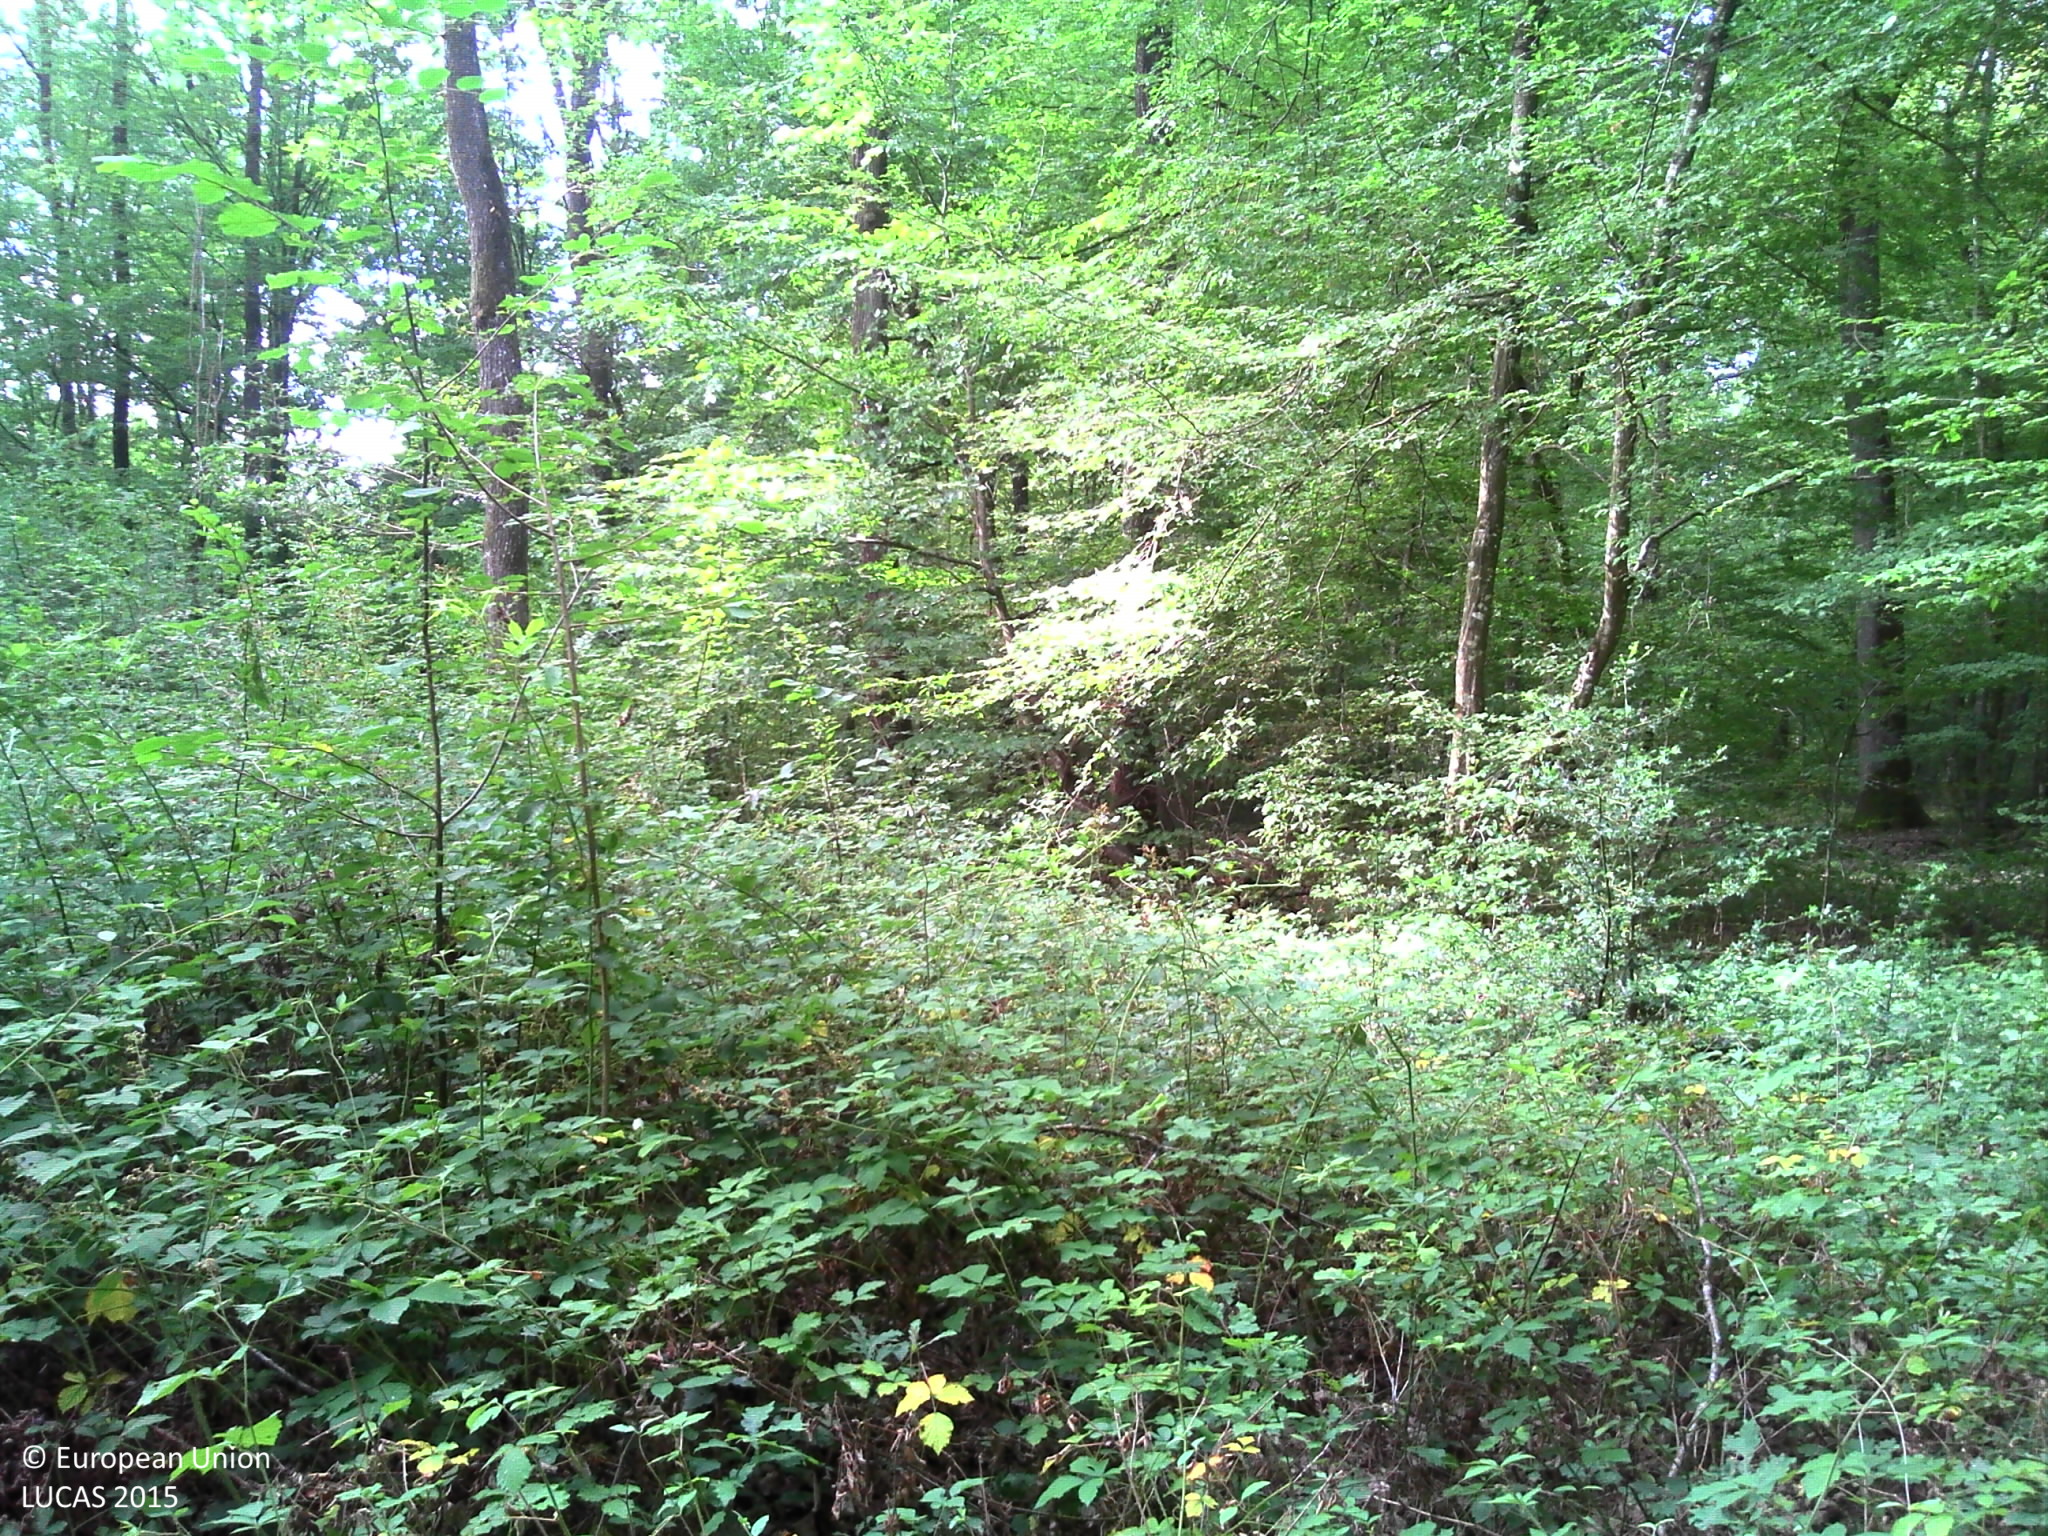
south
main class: Woodland
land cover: Broadleaved woodland
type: mesophytic deciduous forest
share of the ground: > 75 %
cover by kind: broadleaved forest trees 100 %
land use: Forestry
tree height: > 5 m
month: August
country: FR
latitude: 48.0077
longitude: 2.0390
